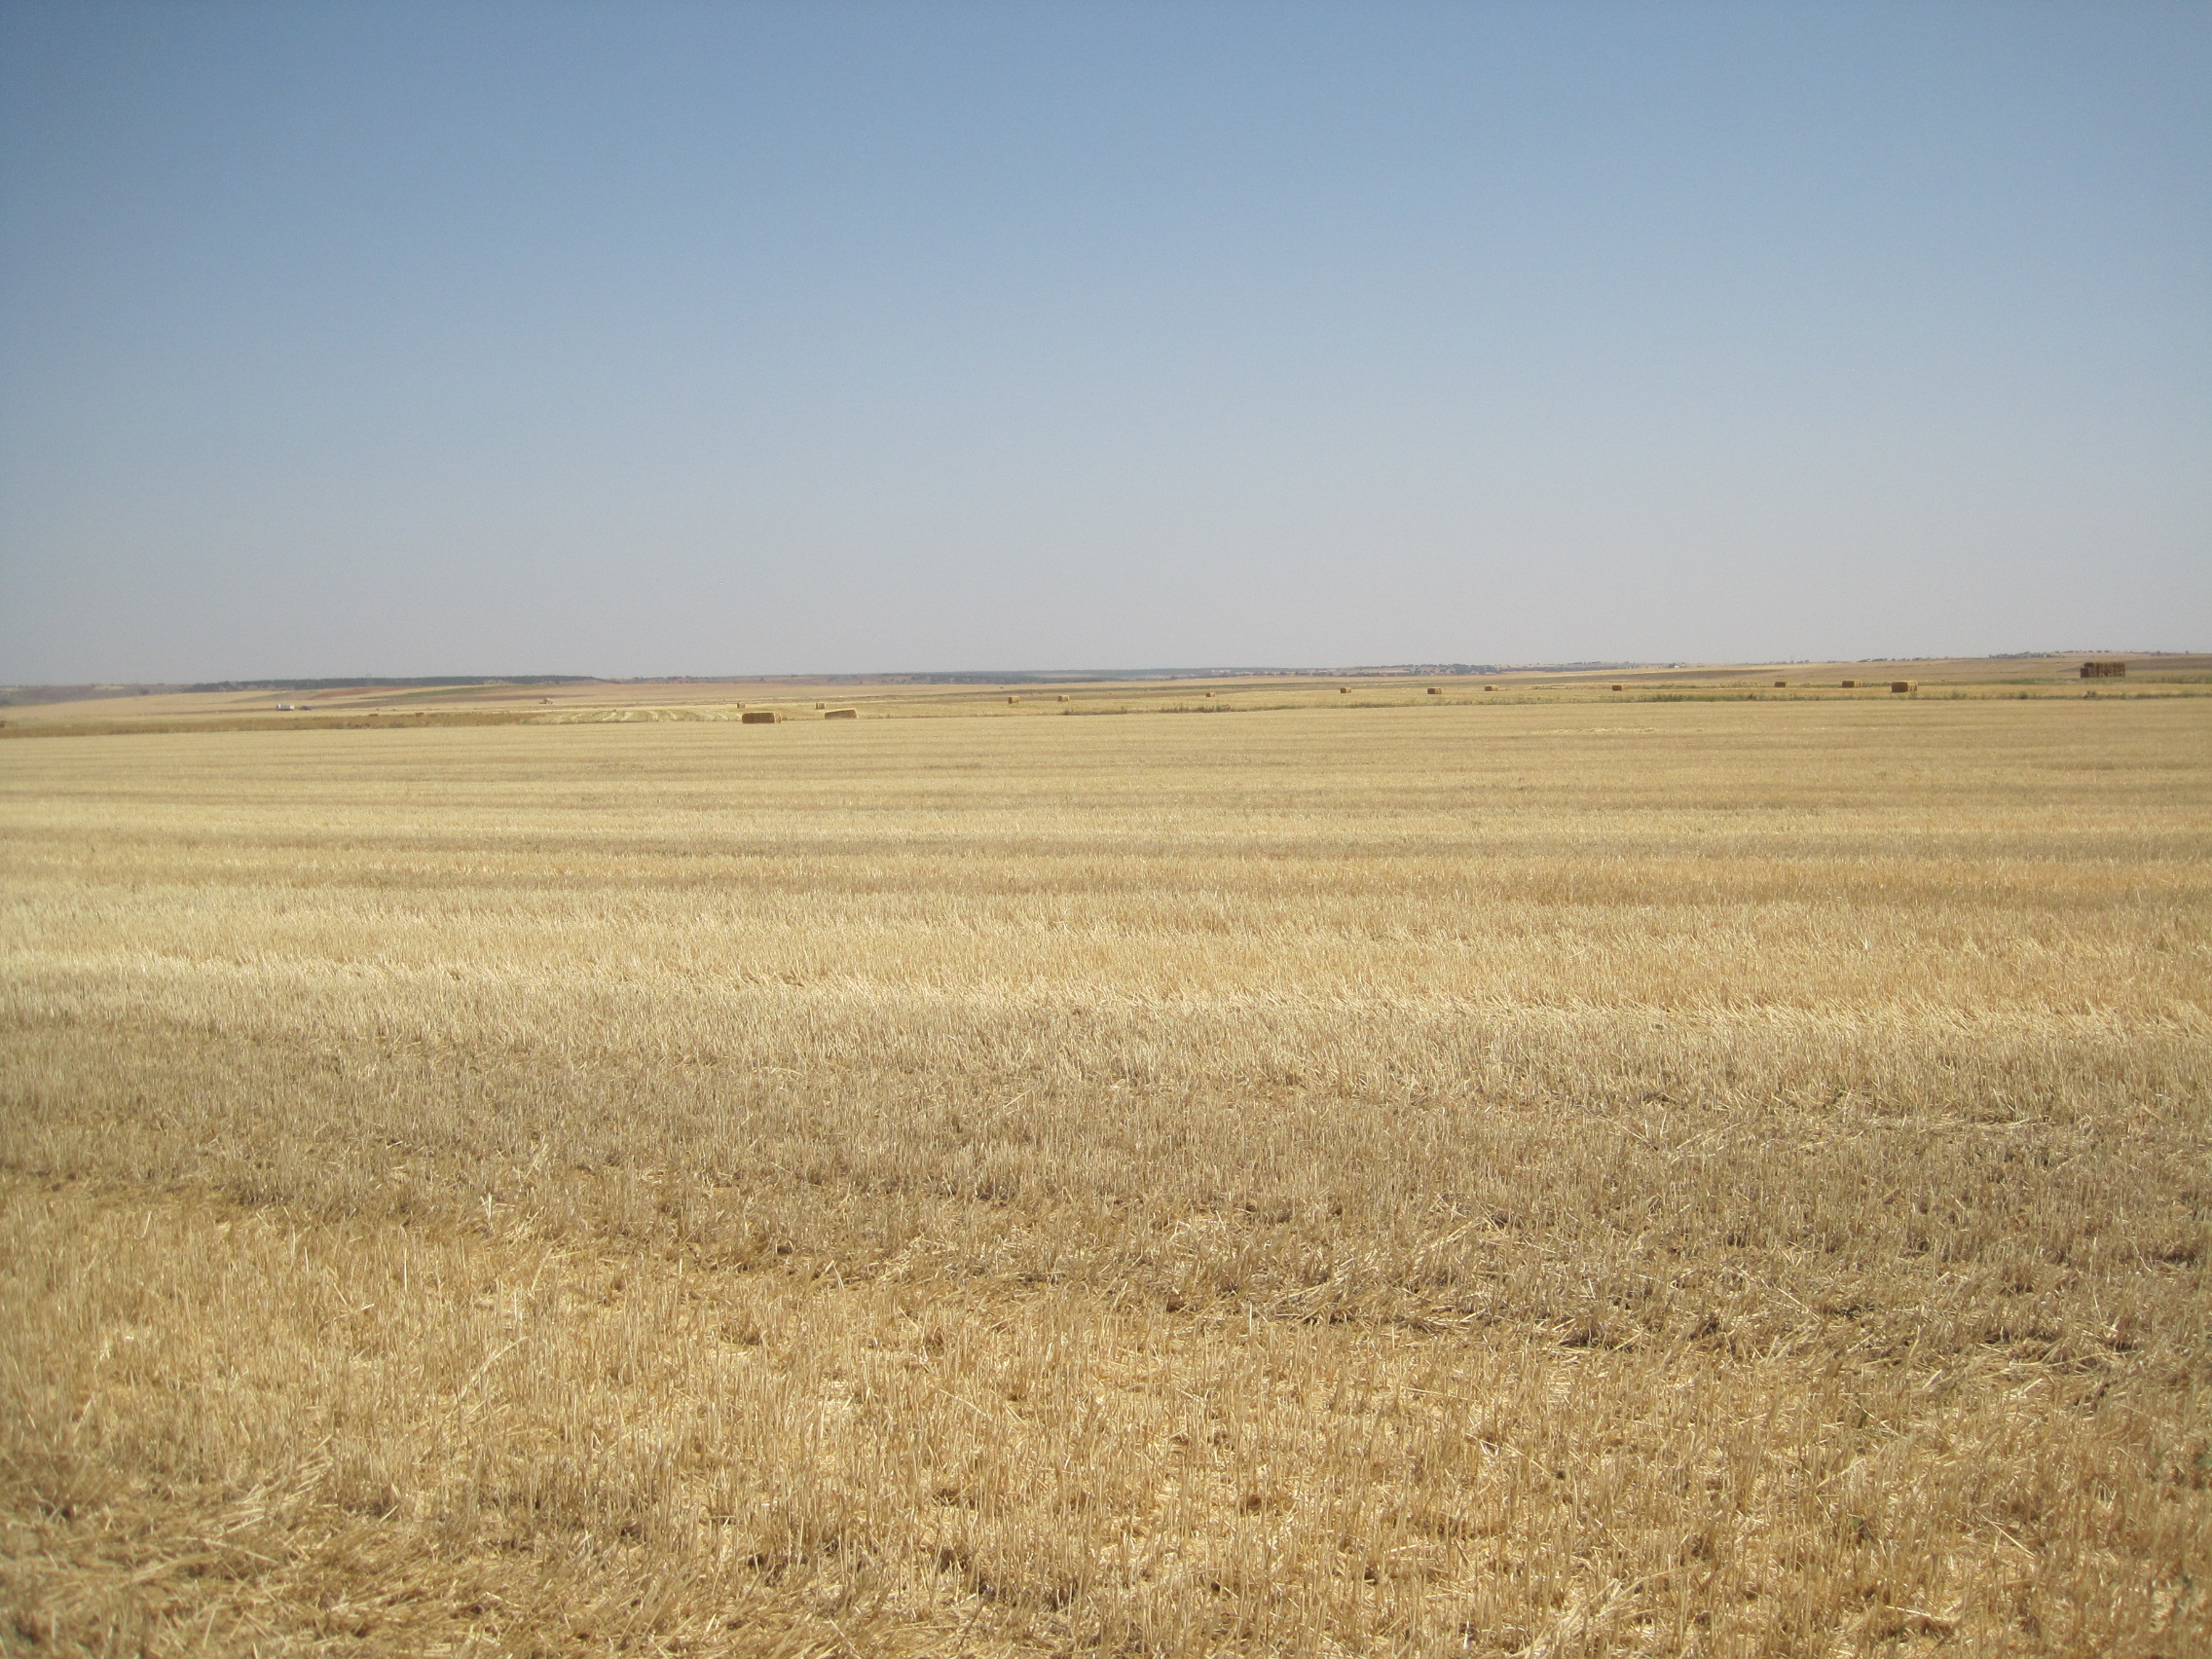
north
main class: Cropland
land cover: Barley
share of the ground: < 10 %
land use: Agriculture (excluding fallow land and kitchen gardens)
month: July
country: ES
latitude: 41.6809
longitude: -5.4475
